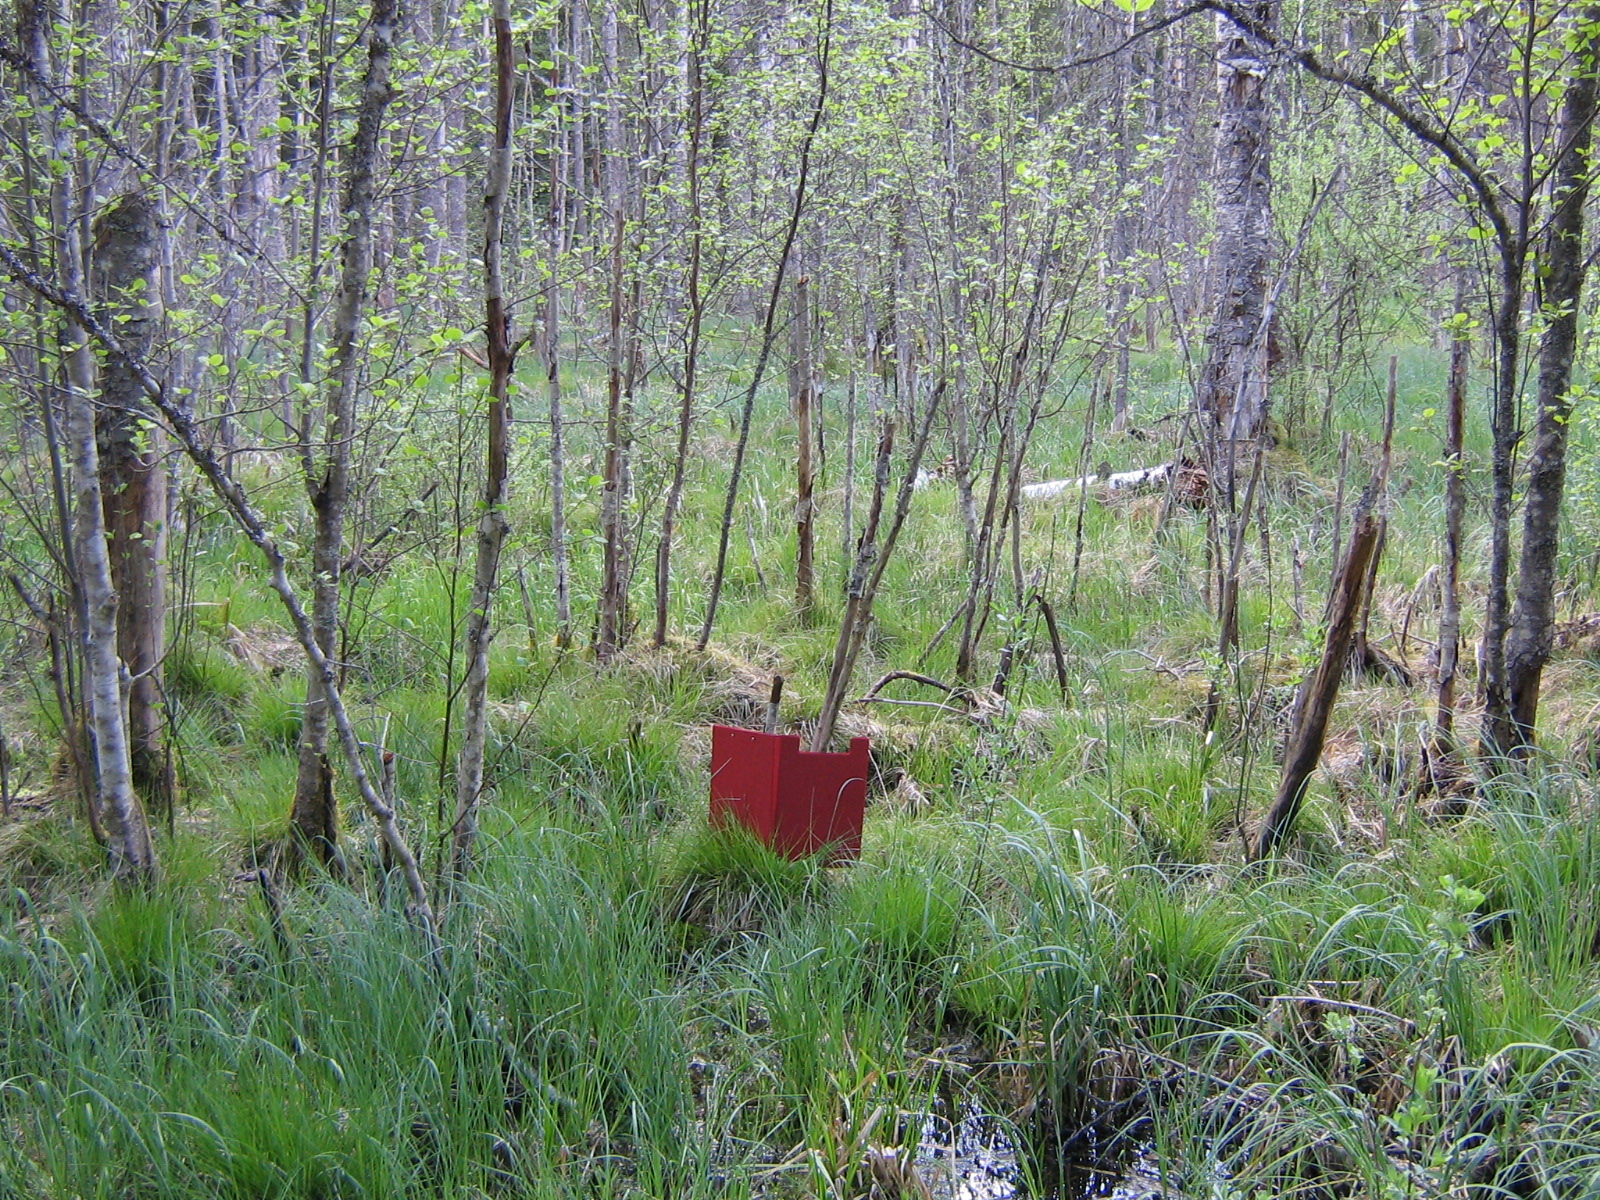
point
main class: Woodland
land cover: Broadleaved woodland
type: floodplain forest
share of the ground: 50 - 75 %
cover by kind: broadleaved forest trees 70 %, herbaceous plants 15 %, lichens and mosses 15 %
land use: Semi-natural and natural areas not in use
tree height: > 5 m
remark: Temporary flooded
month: May
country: LV
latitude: 57.3031
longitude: 25.8775
